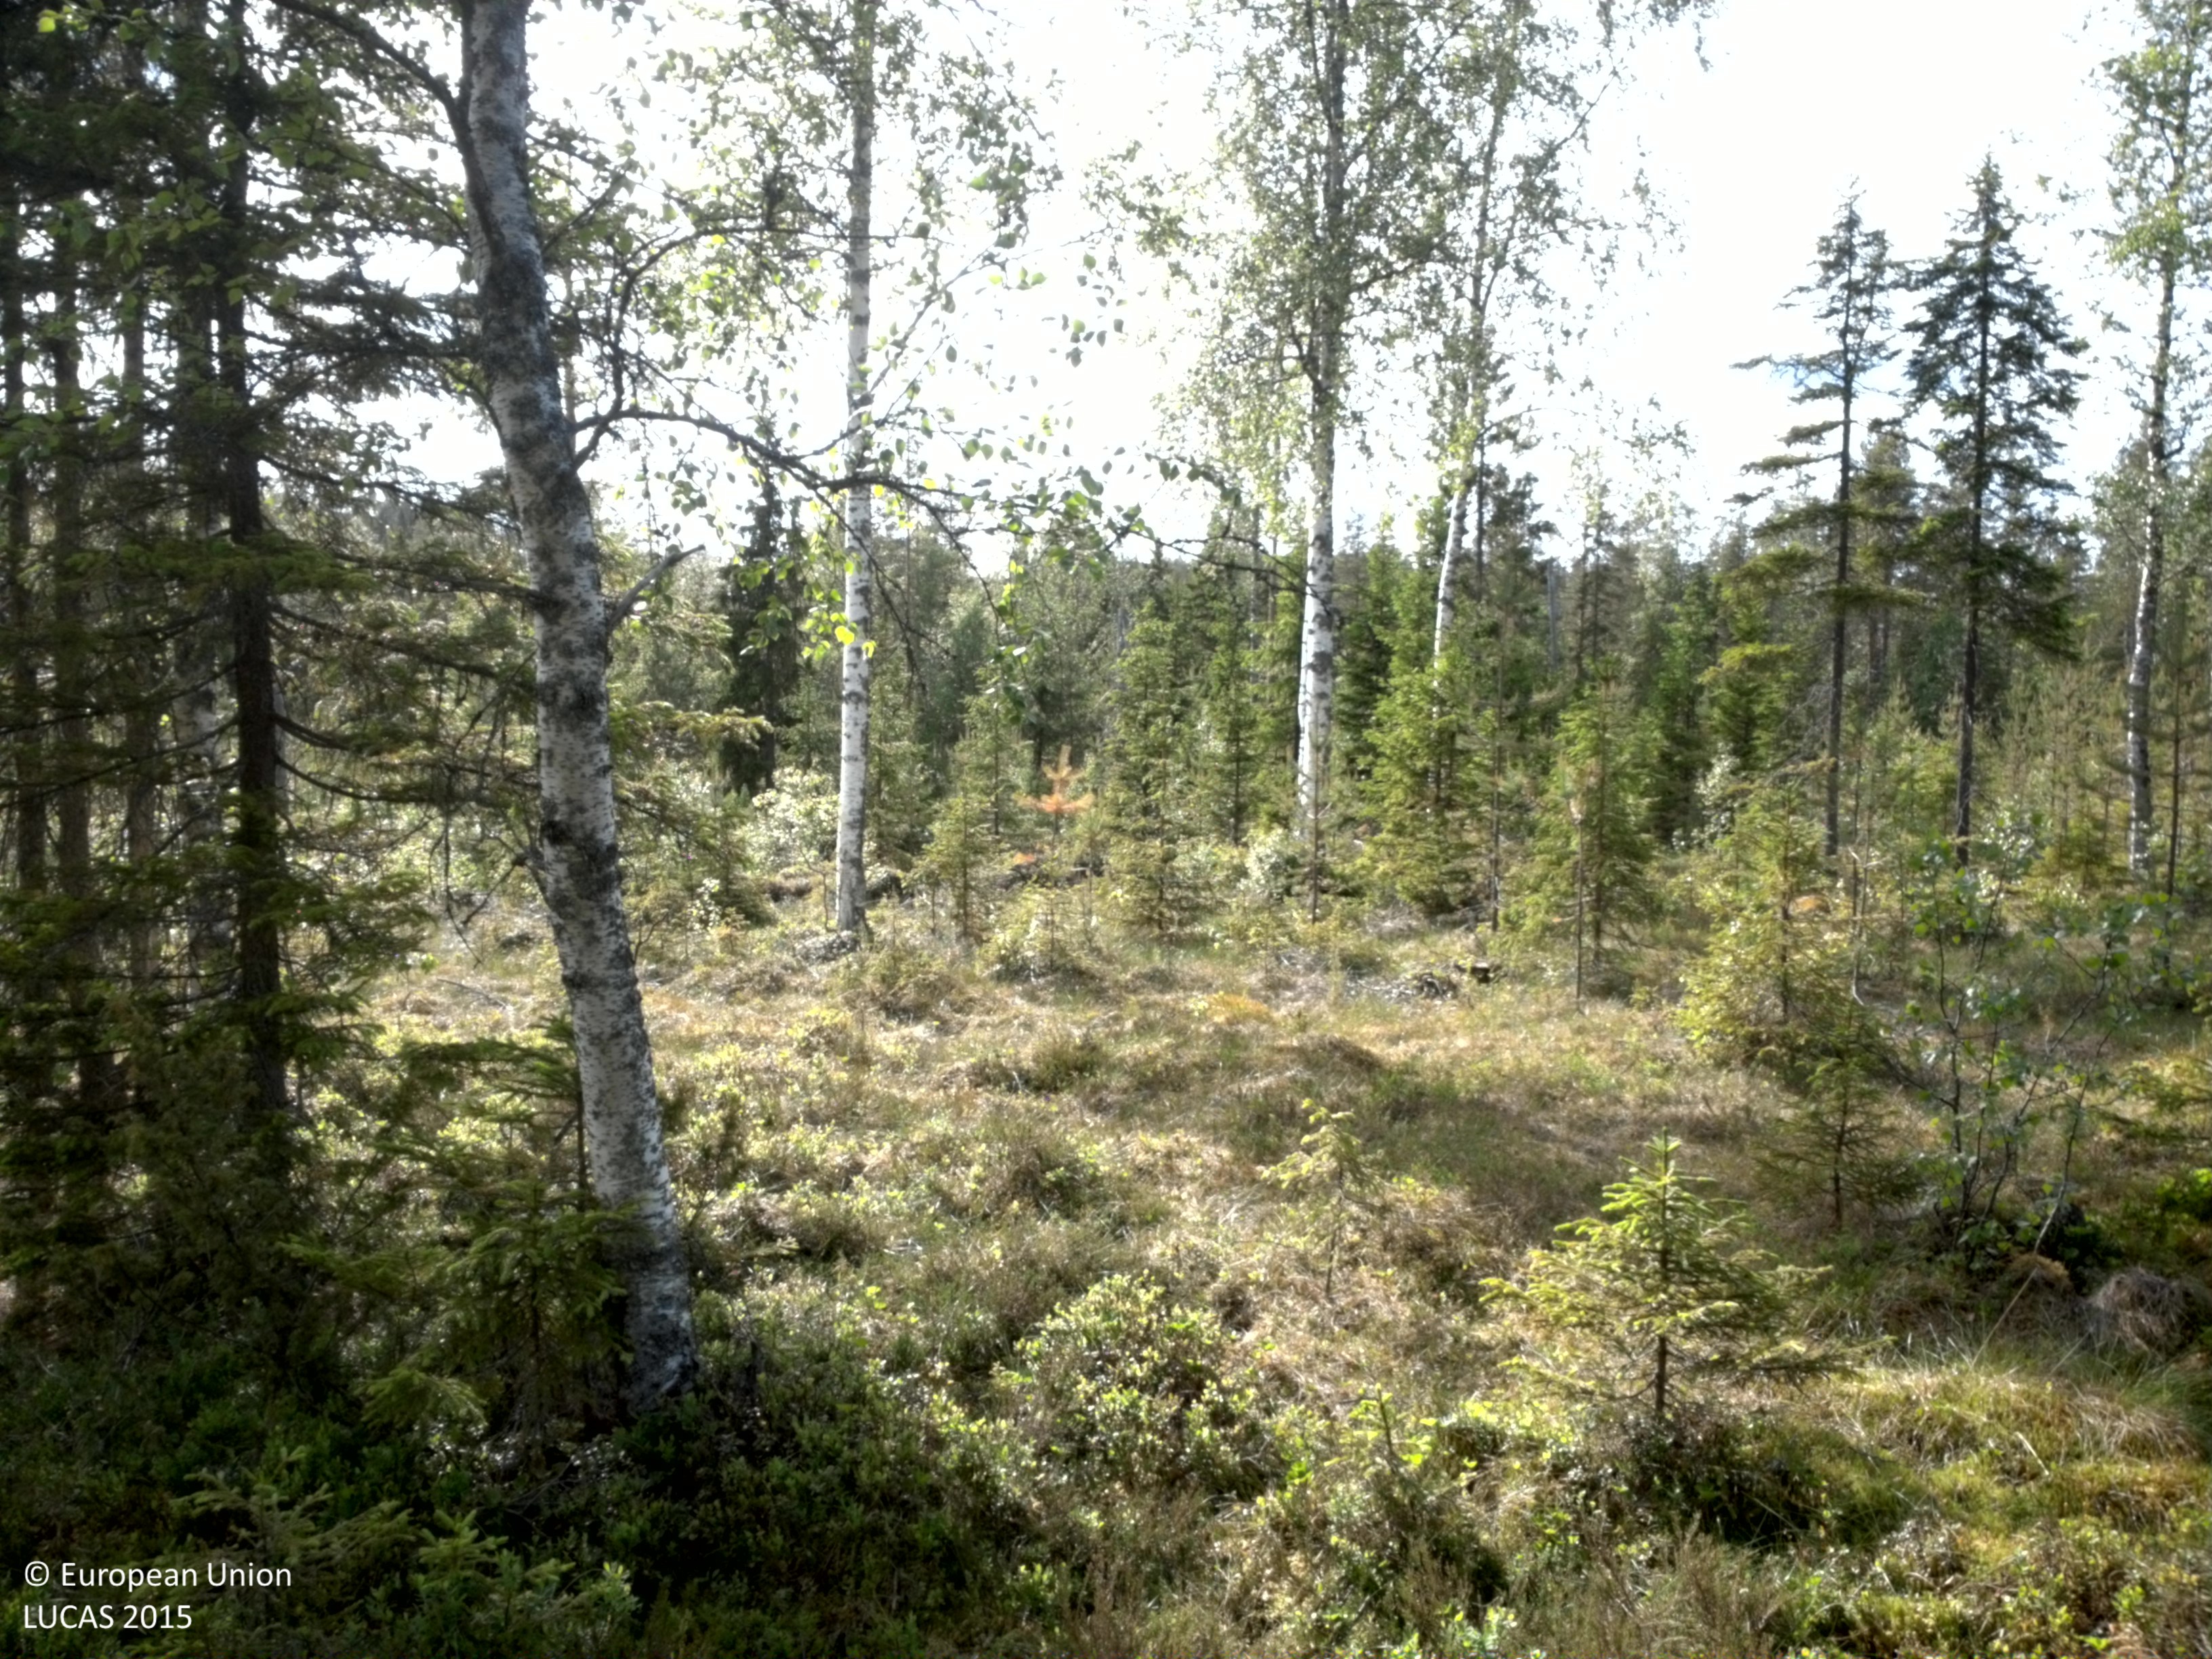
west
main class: Woodland
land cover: Other mixed woodland
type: boreal forest
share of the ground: 50 - 75 %
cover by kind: coniferous forest trees 45 %, shrubs 25 %, broadleaved forest trees 20 %, herbaceous plants 10 %
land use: Forestry
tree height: > 5 m
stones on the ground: < 10 %
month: July
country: SE
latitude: 64.3526
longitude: 20.6020
